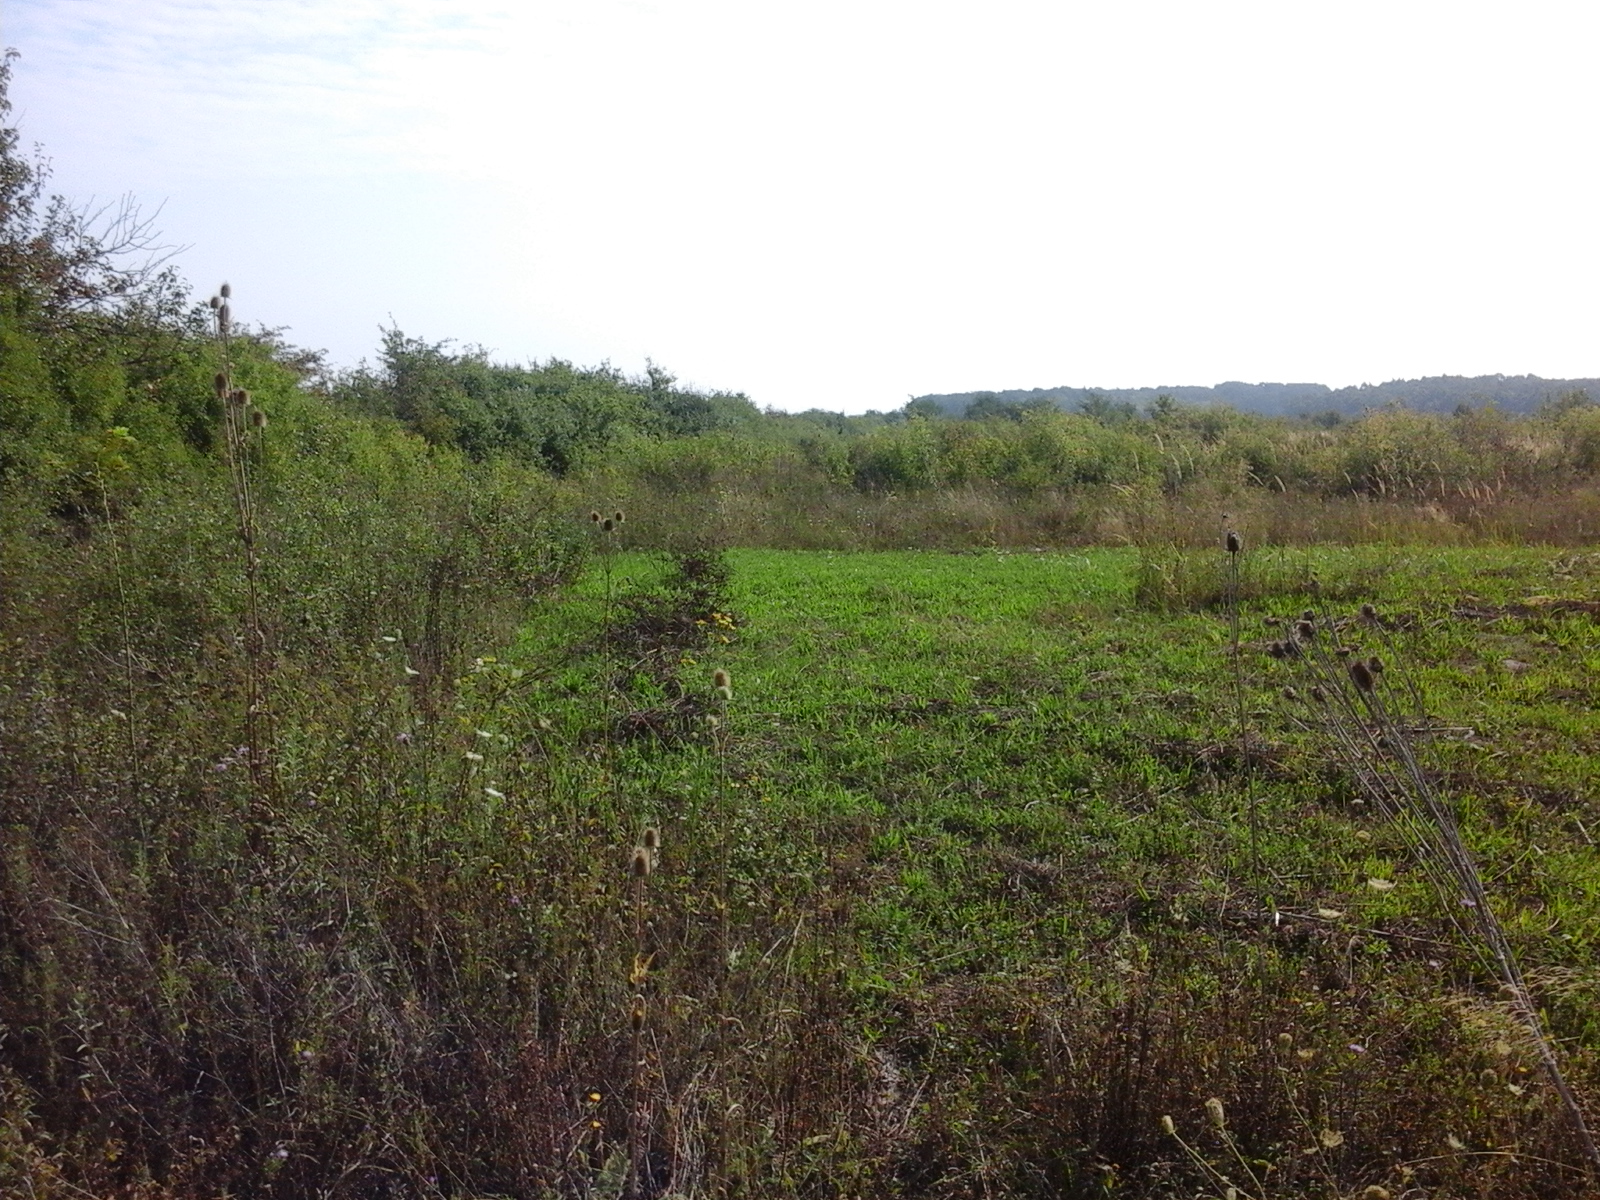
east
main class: Grassland
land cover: Spontaneously vegetated surfaces
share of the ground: > 75 %
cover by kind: herbaceous plants 100 %
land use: Agriculture (excluding fallow land and kitchen gardens)
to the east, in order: Spontaneously vegetated surfaces; Shrubland without tree cover
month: August
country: RO
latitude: 46.6046
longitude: 21.8051
